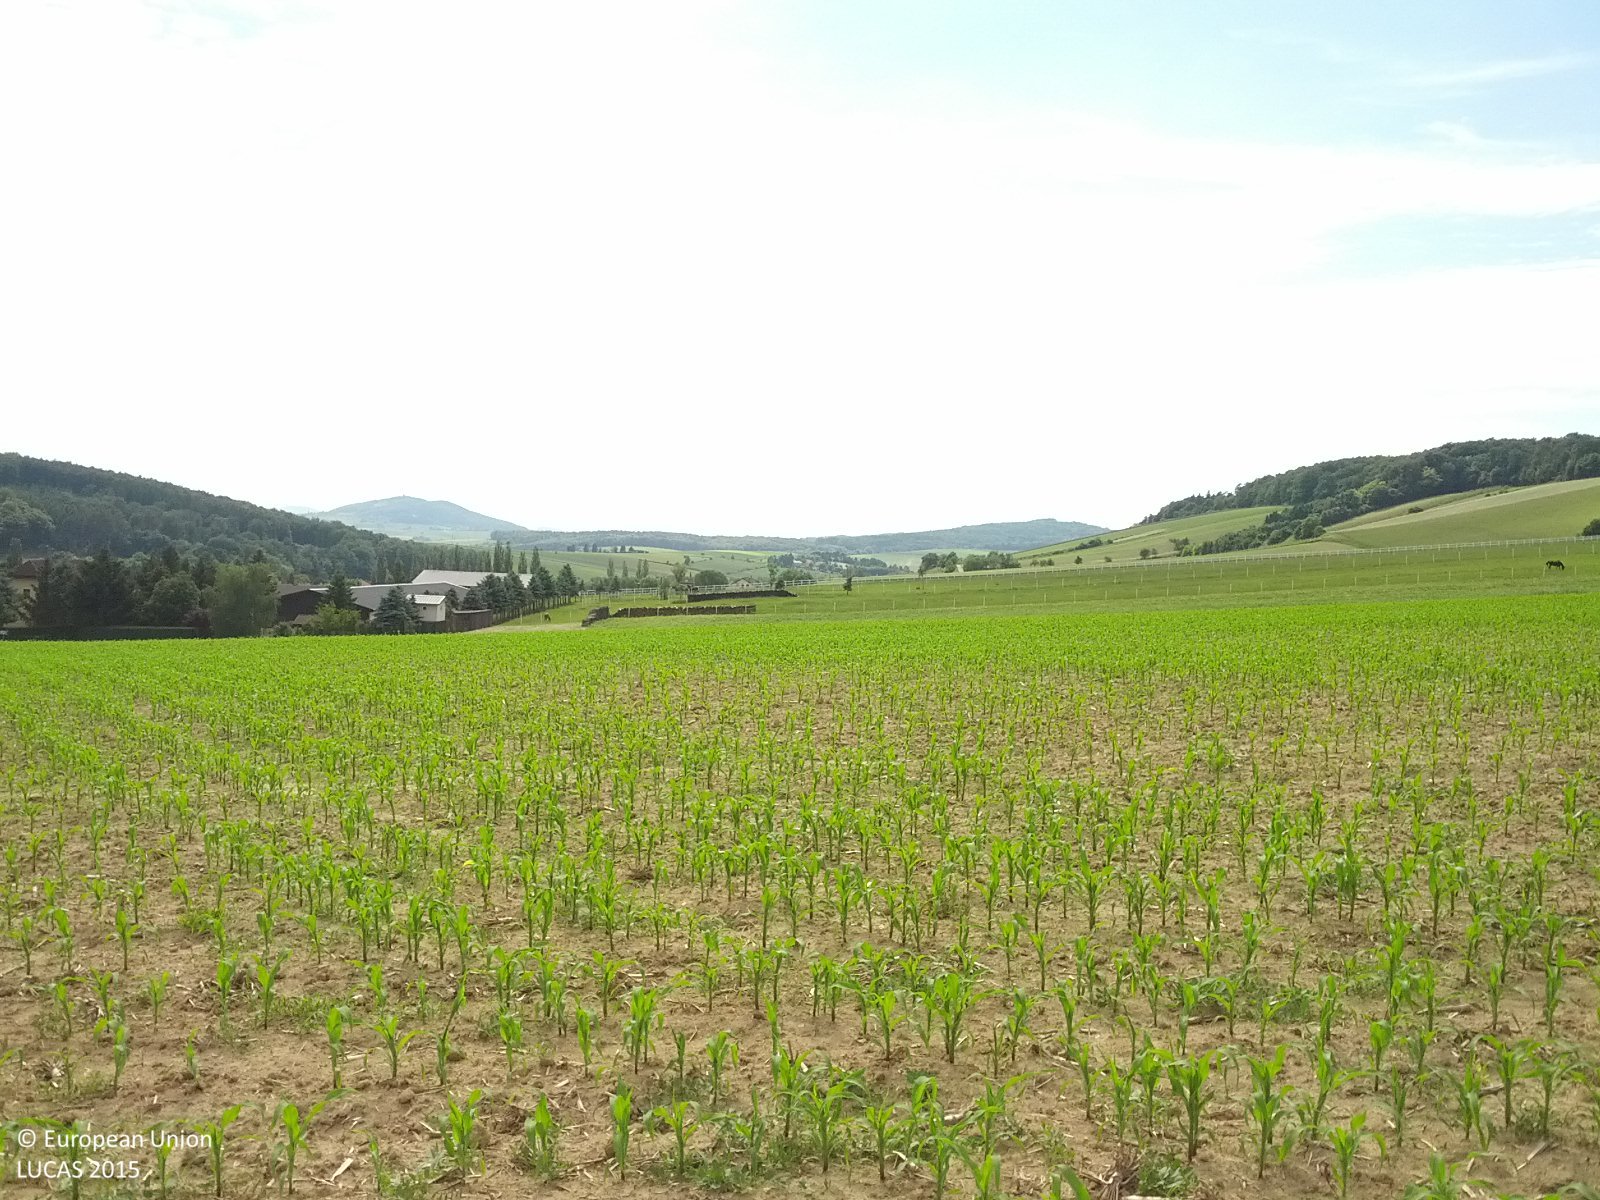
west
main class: Cropland
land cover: Barley
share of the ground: > 75 %
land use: Agriculture (excluding fallow land and kitchen gardens)
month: June
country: AT
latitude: 48.2558
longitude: 16.0516
